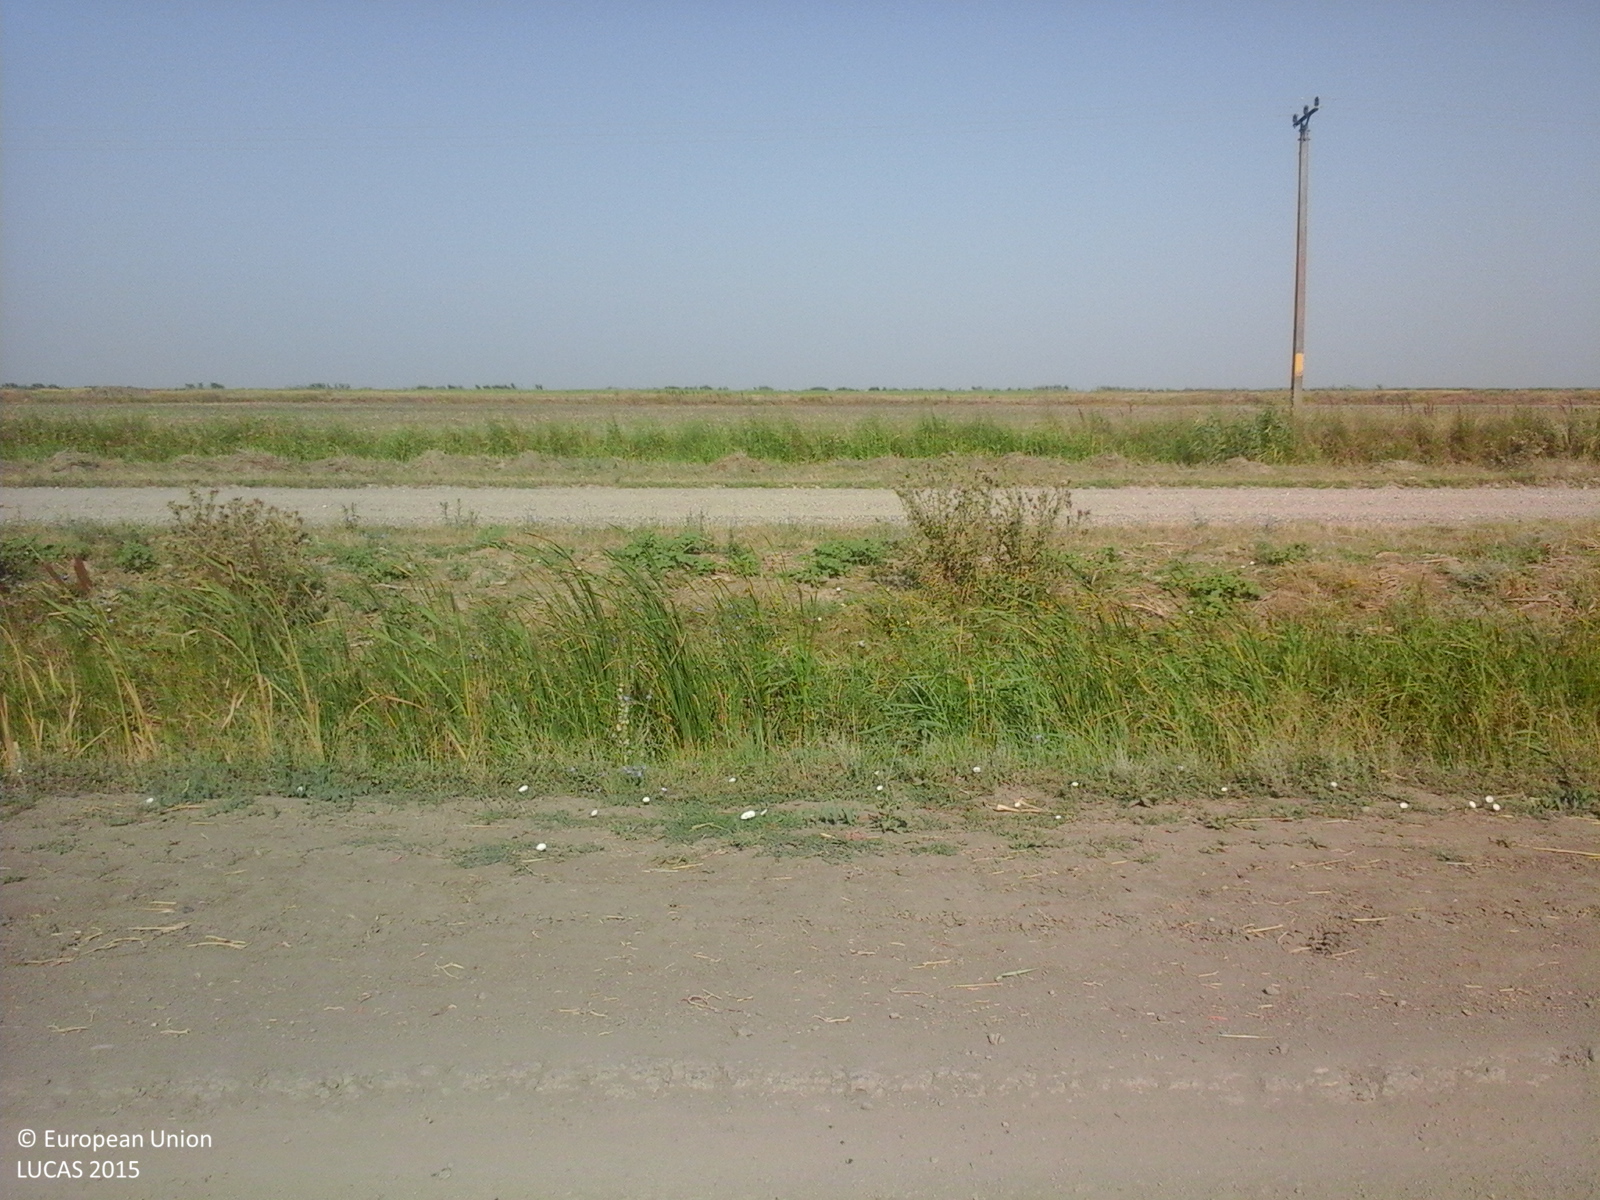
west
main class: Cropland
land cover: Rice
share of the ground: > 75 %
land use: Agriculture (excluding fallow land and kitchen gardens)
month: August
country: RO
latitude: 45.3733
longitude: 27.8216
